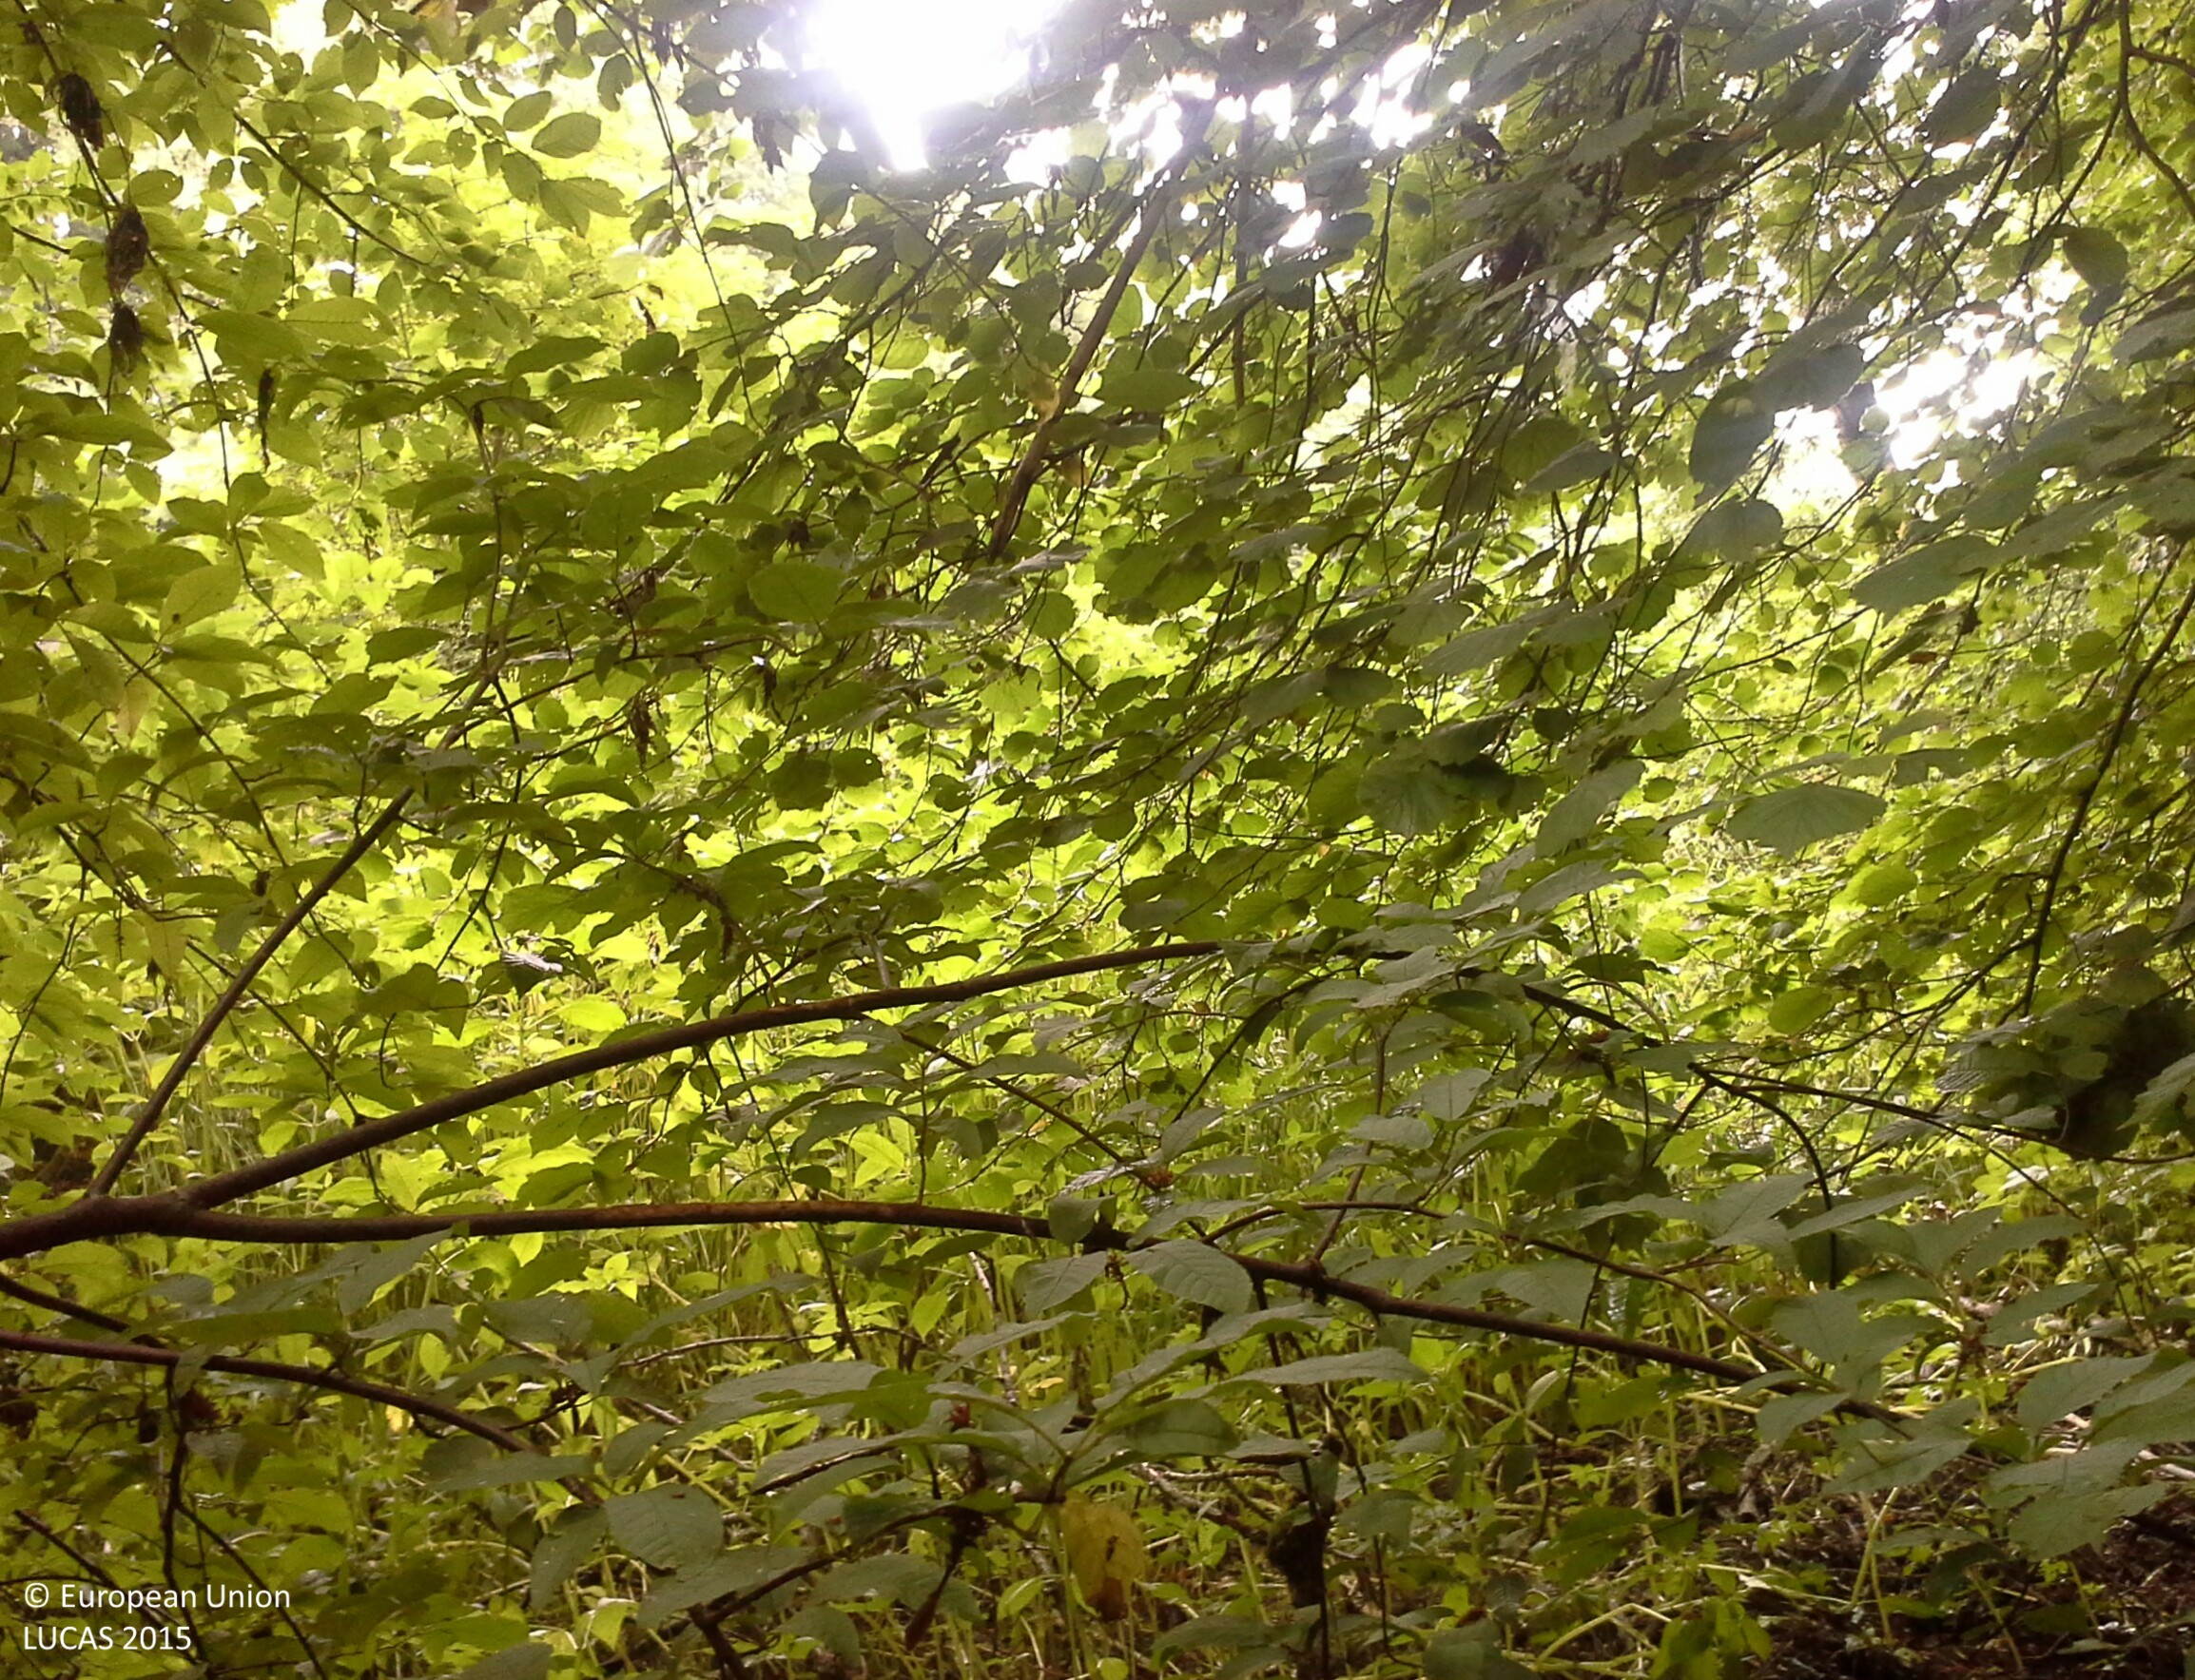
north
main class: Woodland
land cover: Broadleaved woodland
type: floodplain forest
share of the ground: > 75 %
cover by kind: broadleaved forest trees 80 %, shrubs 15 %, herbaceous plants 5 %
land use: Forestry
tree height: > 5 m
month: July
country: AT
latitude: 48.0821
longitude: 14.8198
